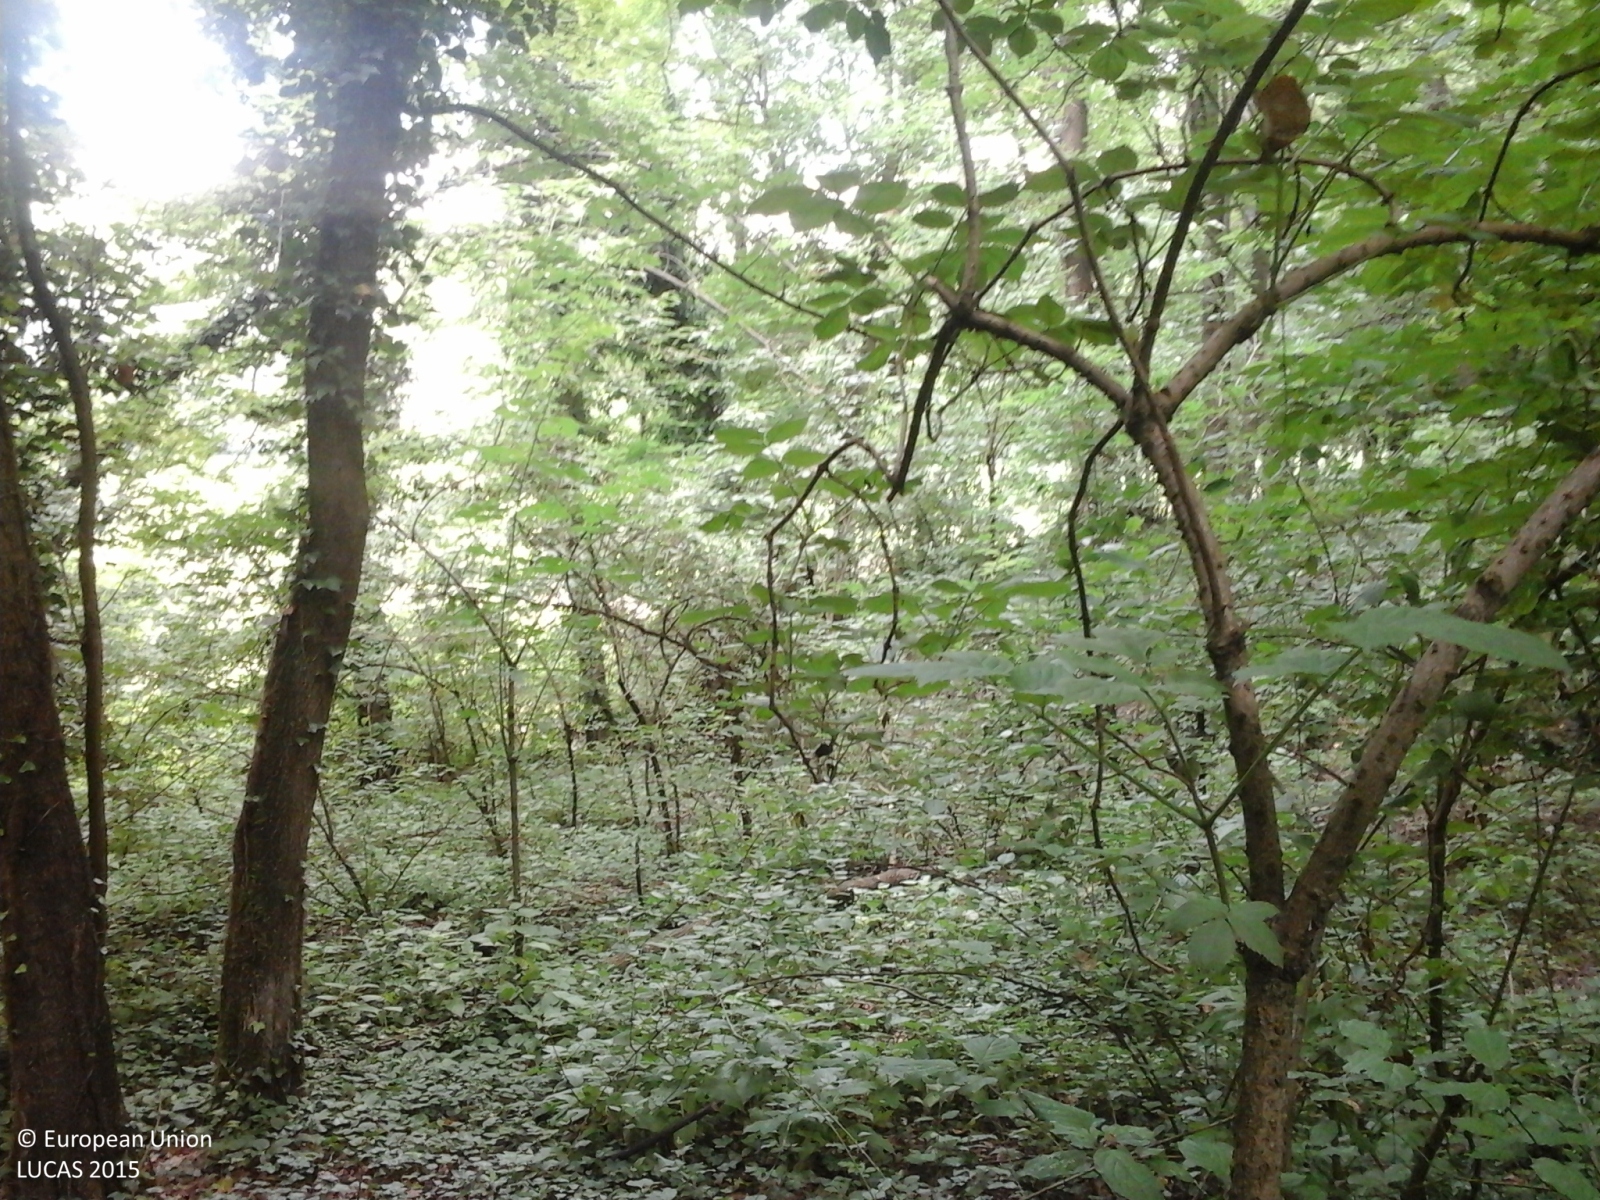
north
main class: Woodland
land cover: Broadleaved woodland
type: thermophilous deciduous forest
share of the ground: > 75 %
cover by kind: broadleaved forest trees 100 %
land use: Forestry
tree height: > 5 m
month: June
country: IT
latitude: 45.1480
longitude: 8.2861
